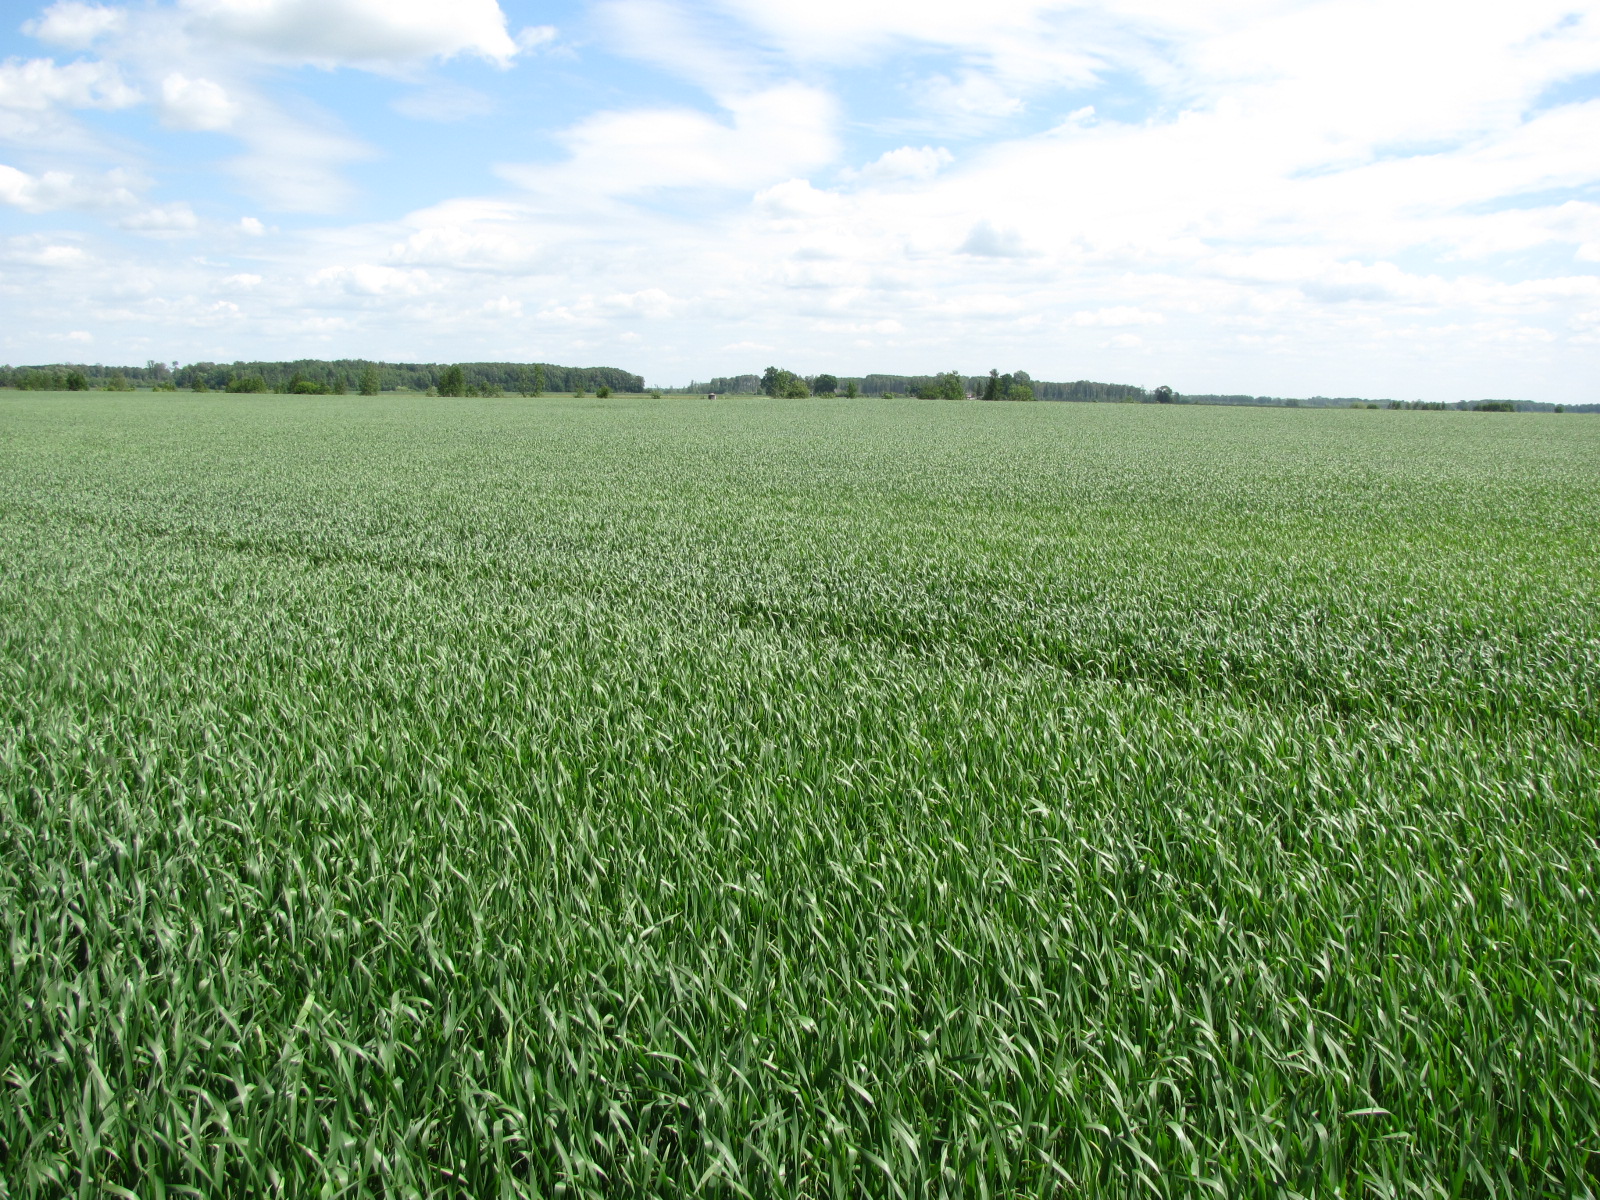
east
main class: Cropland
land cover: Common wheat
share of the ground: > 75 %
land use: Agriculture (excluding fallow land and kitchen gardens)
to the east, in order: Common wheat
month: June
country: LV
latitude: 56.2718
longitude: 24.1877
